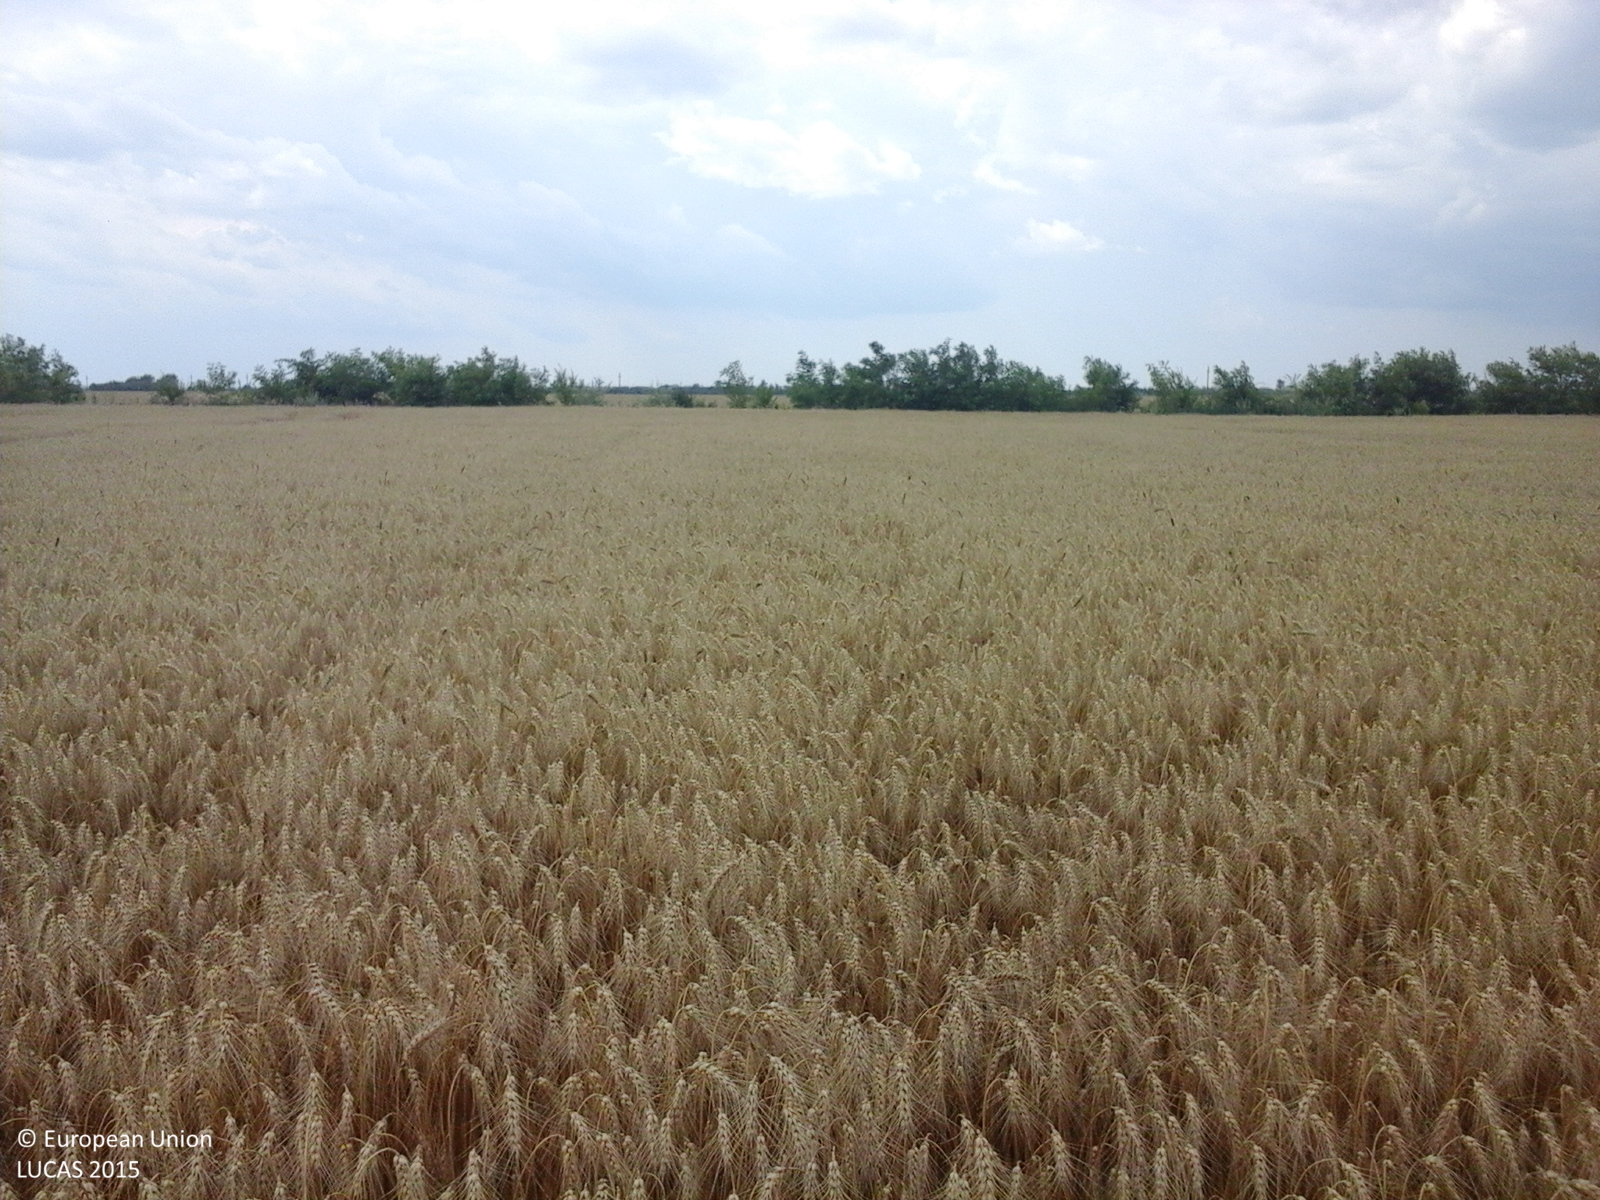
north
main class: Cropland
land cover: Common wheat
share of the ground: > 75 %
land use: Agriculture (excluding fallow land and kitchen gardens)
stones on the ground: < 10 %
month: July
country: RO
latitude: 44.0527
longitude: 24.4070
